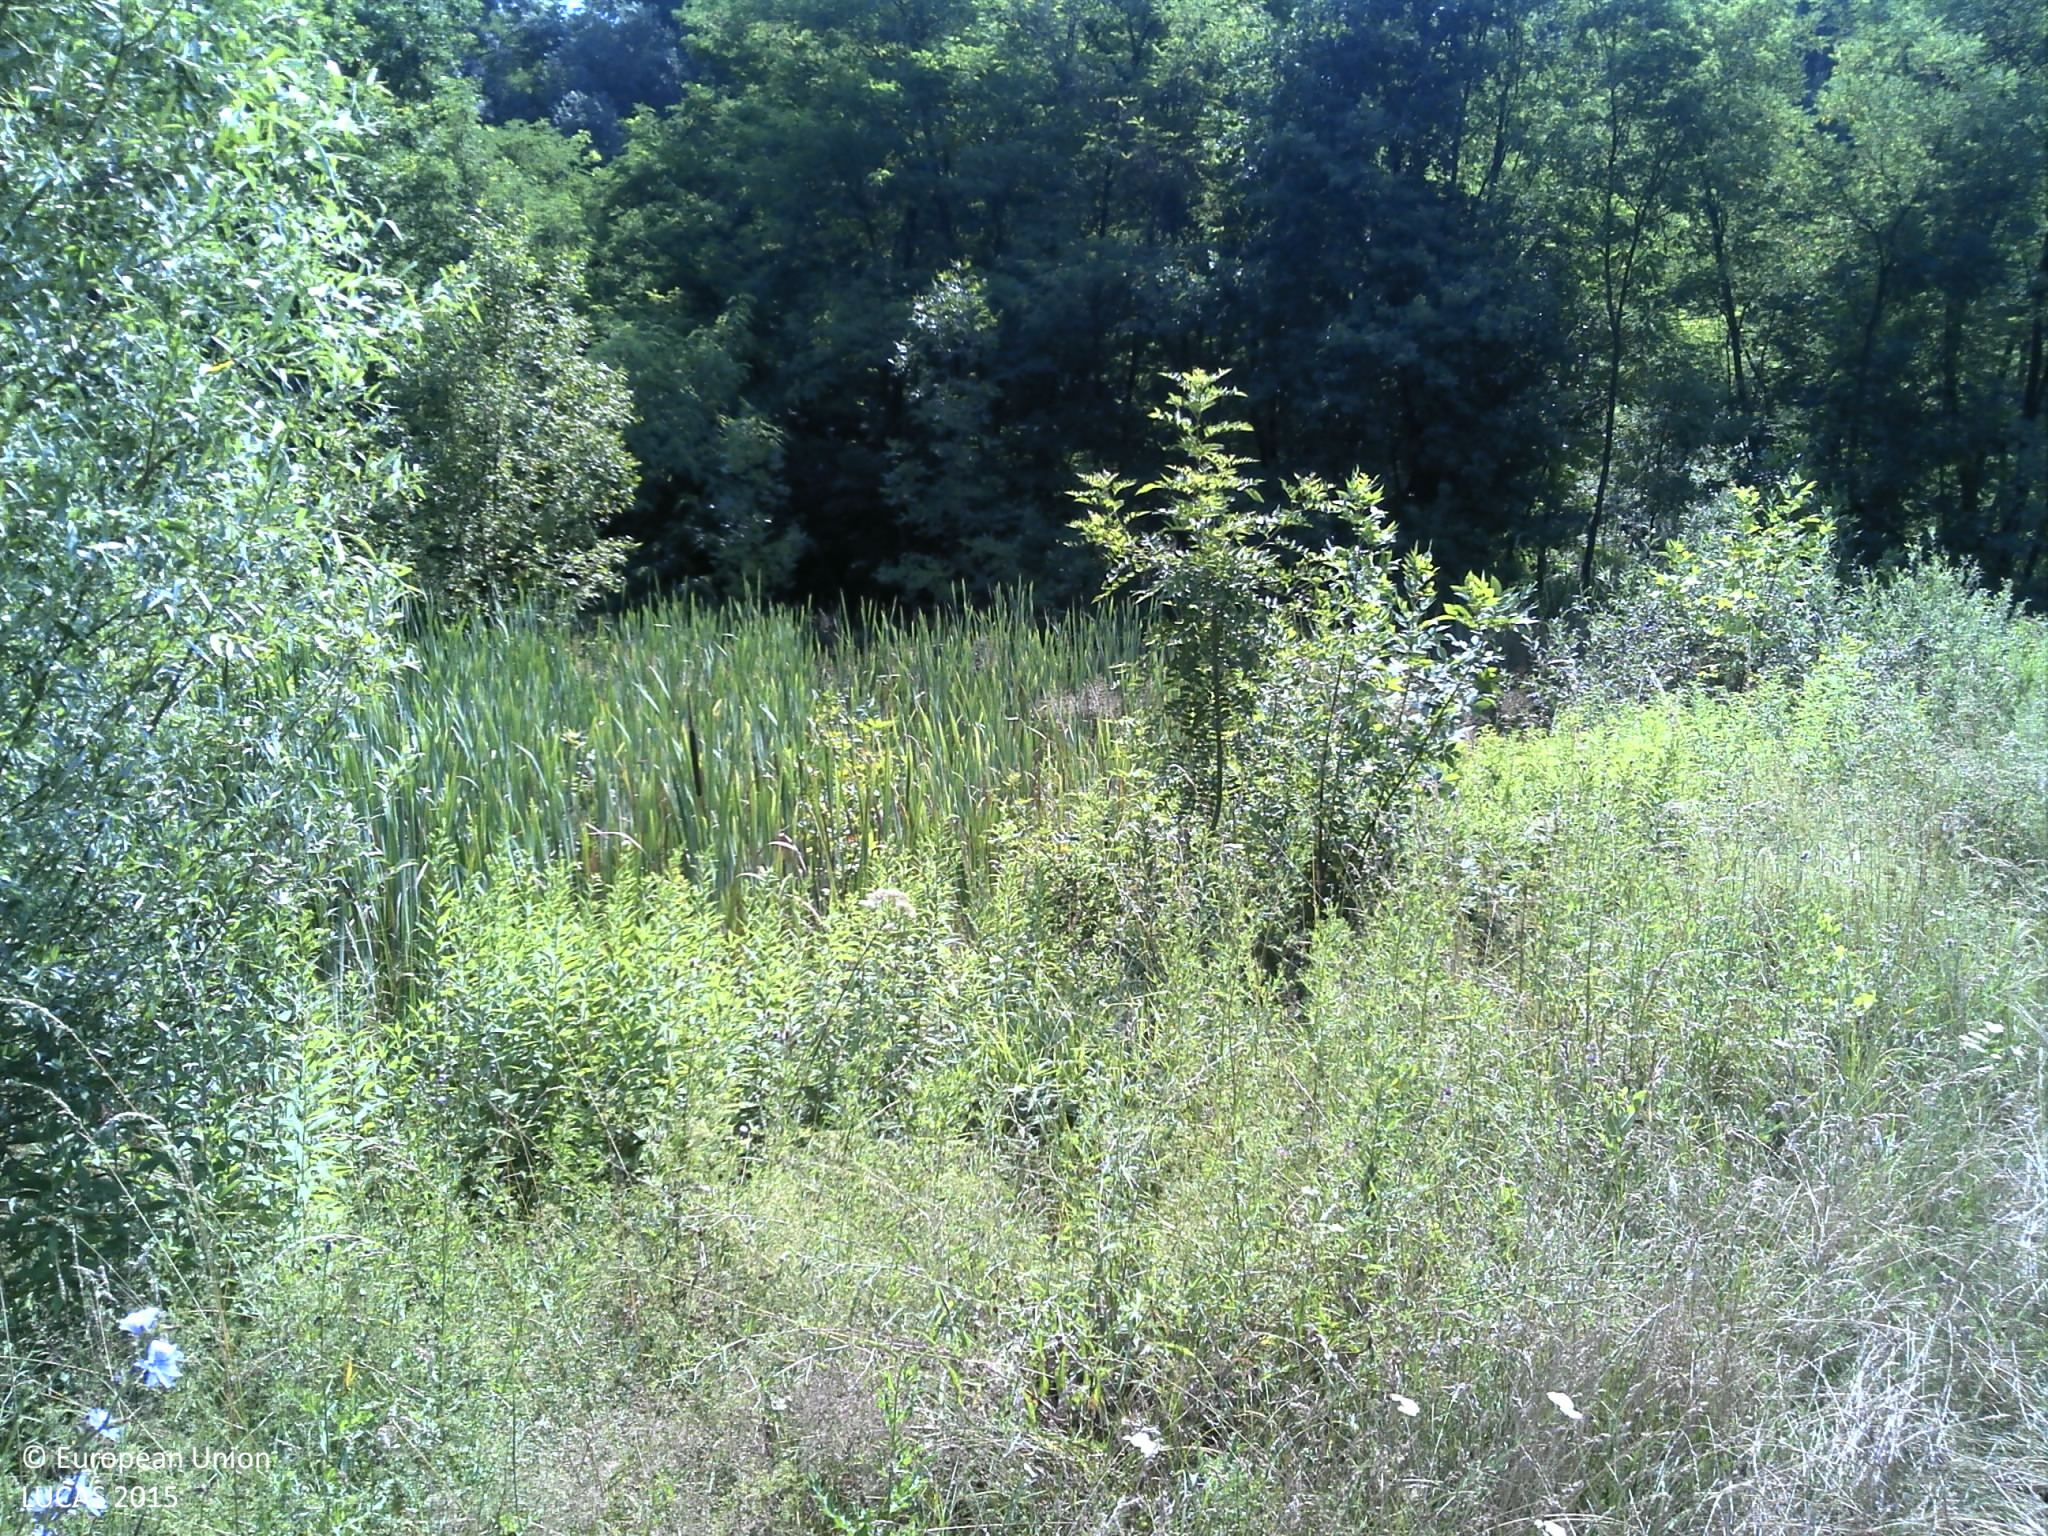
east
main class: Grassland
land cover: Spontaneously vegetated surfaces
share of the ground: > 75 %
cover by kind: herbaceous plants 100 %
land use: Fallow land
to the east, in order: Spontaneously vegetated surfaces; Tracks; Inland marshes; Broadleaved woodland
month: July
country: HR
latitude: 45.7876
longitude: 16.5724
